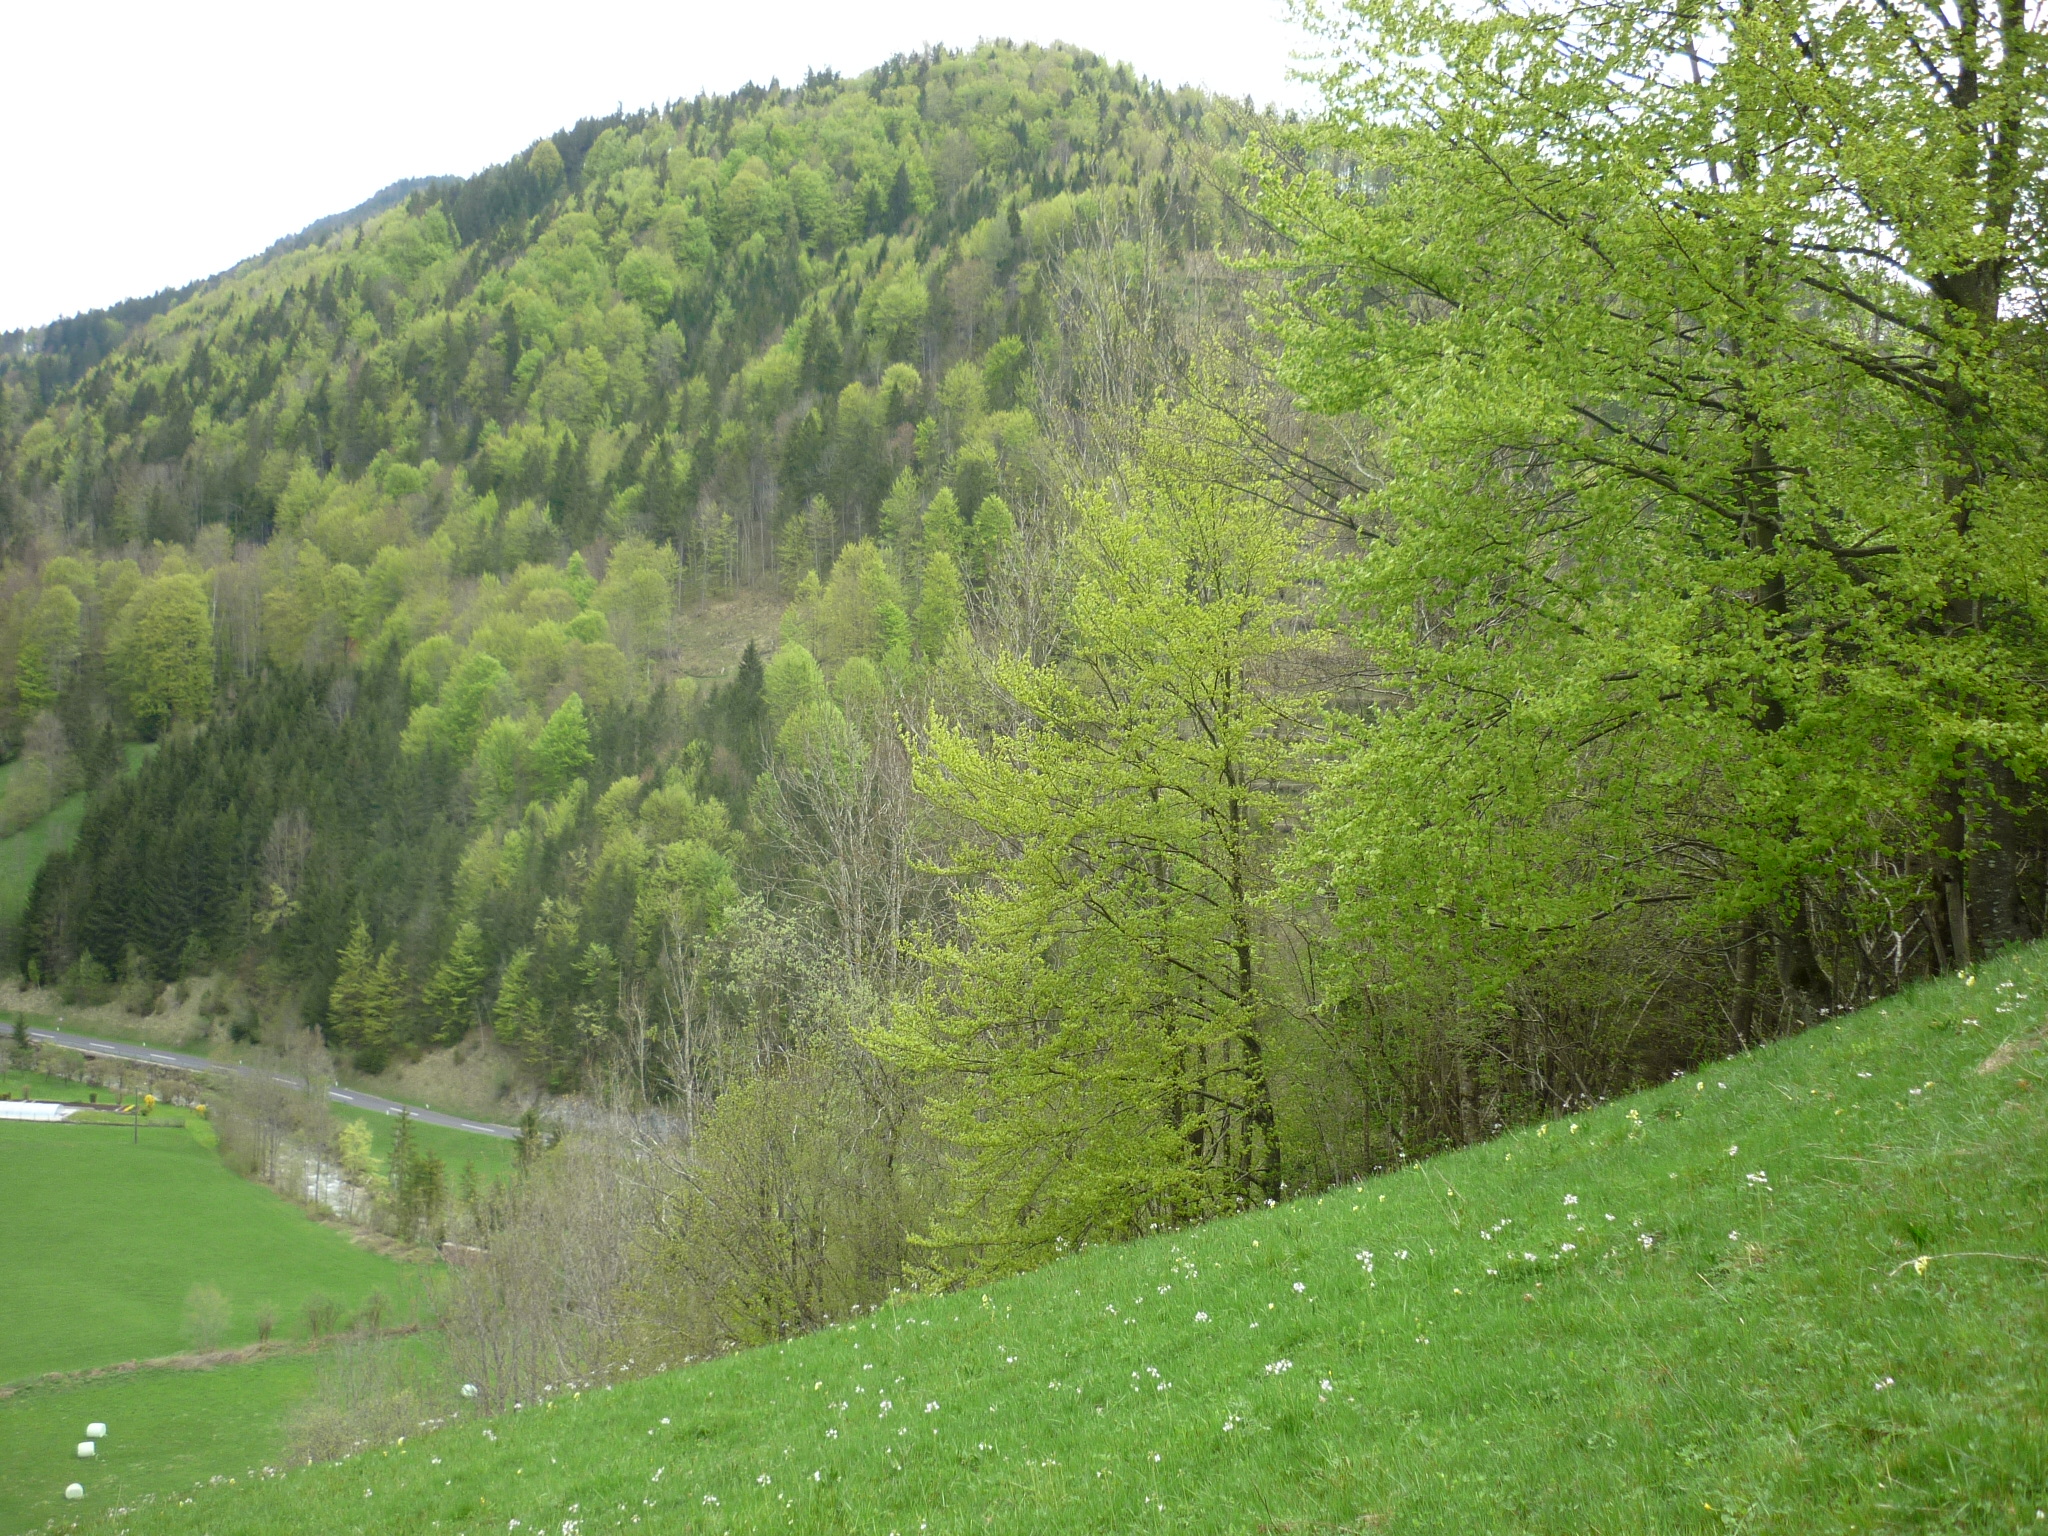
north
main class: Grassland
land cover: Grassland without tree/shrub cover
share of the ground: > 75 %
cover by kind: herbaceous plants 90 %, lichens and mosses 5 %, unconsolidated bare surface 5 %
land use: Agriculture (excluding fallow land and kitchen gardens)
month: May
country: AT
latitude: 47.7142
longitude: 14.5716
